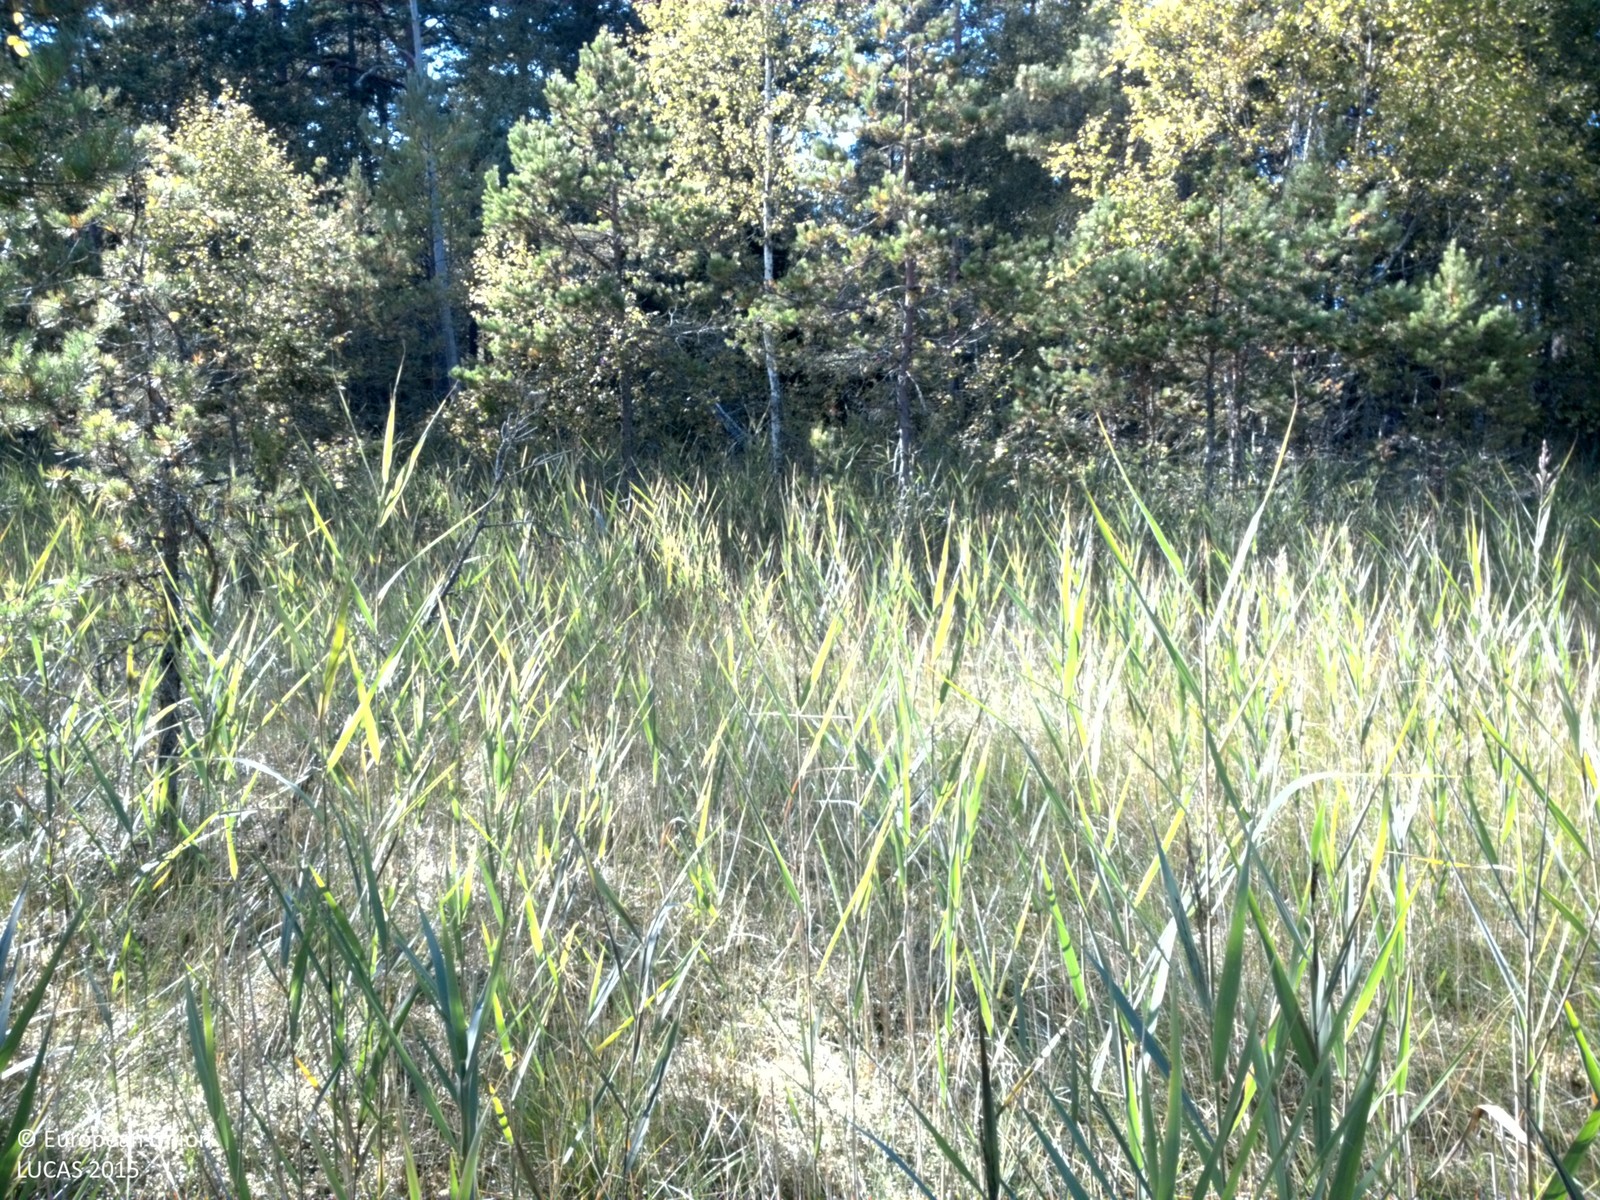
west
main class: Woodland
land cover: Pine dominated coniferous woodland
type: boreal forest
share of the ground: 25 - 50 %
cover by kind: lichens and mosses 55 %, coniferous forest trees 30 %, herbaceous plants 10 %, shrubs 5 %
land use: Forestry
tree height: < 5 m
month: August
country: SE
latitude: 59.7867
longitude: 17.7449
